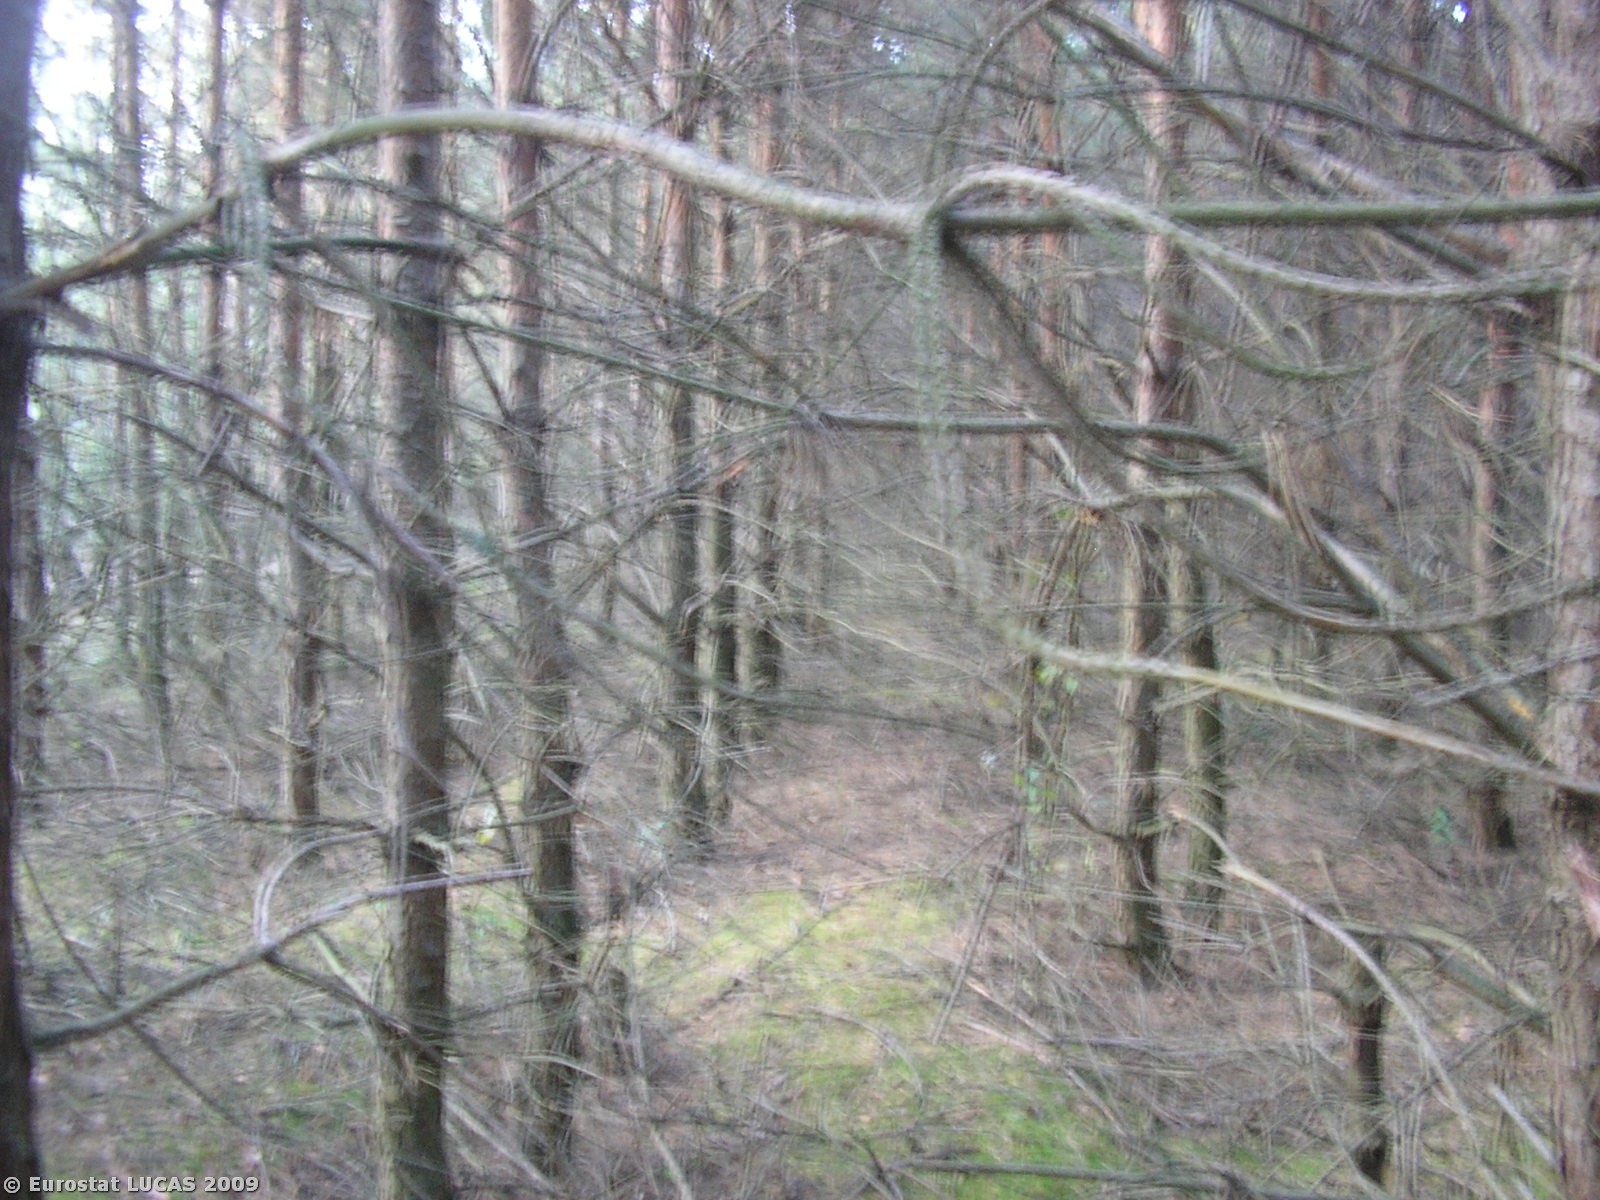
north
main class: Woodland
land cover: Coniferous woodland
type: hemiboreal forest and nemoral coniferous forest and mixed broadleaved-coniferous forest
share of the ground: > 75 %
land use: Forestry
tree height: > 5 m
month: September
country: PL
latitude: 51.7083
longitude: 21.1168
